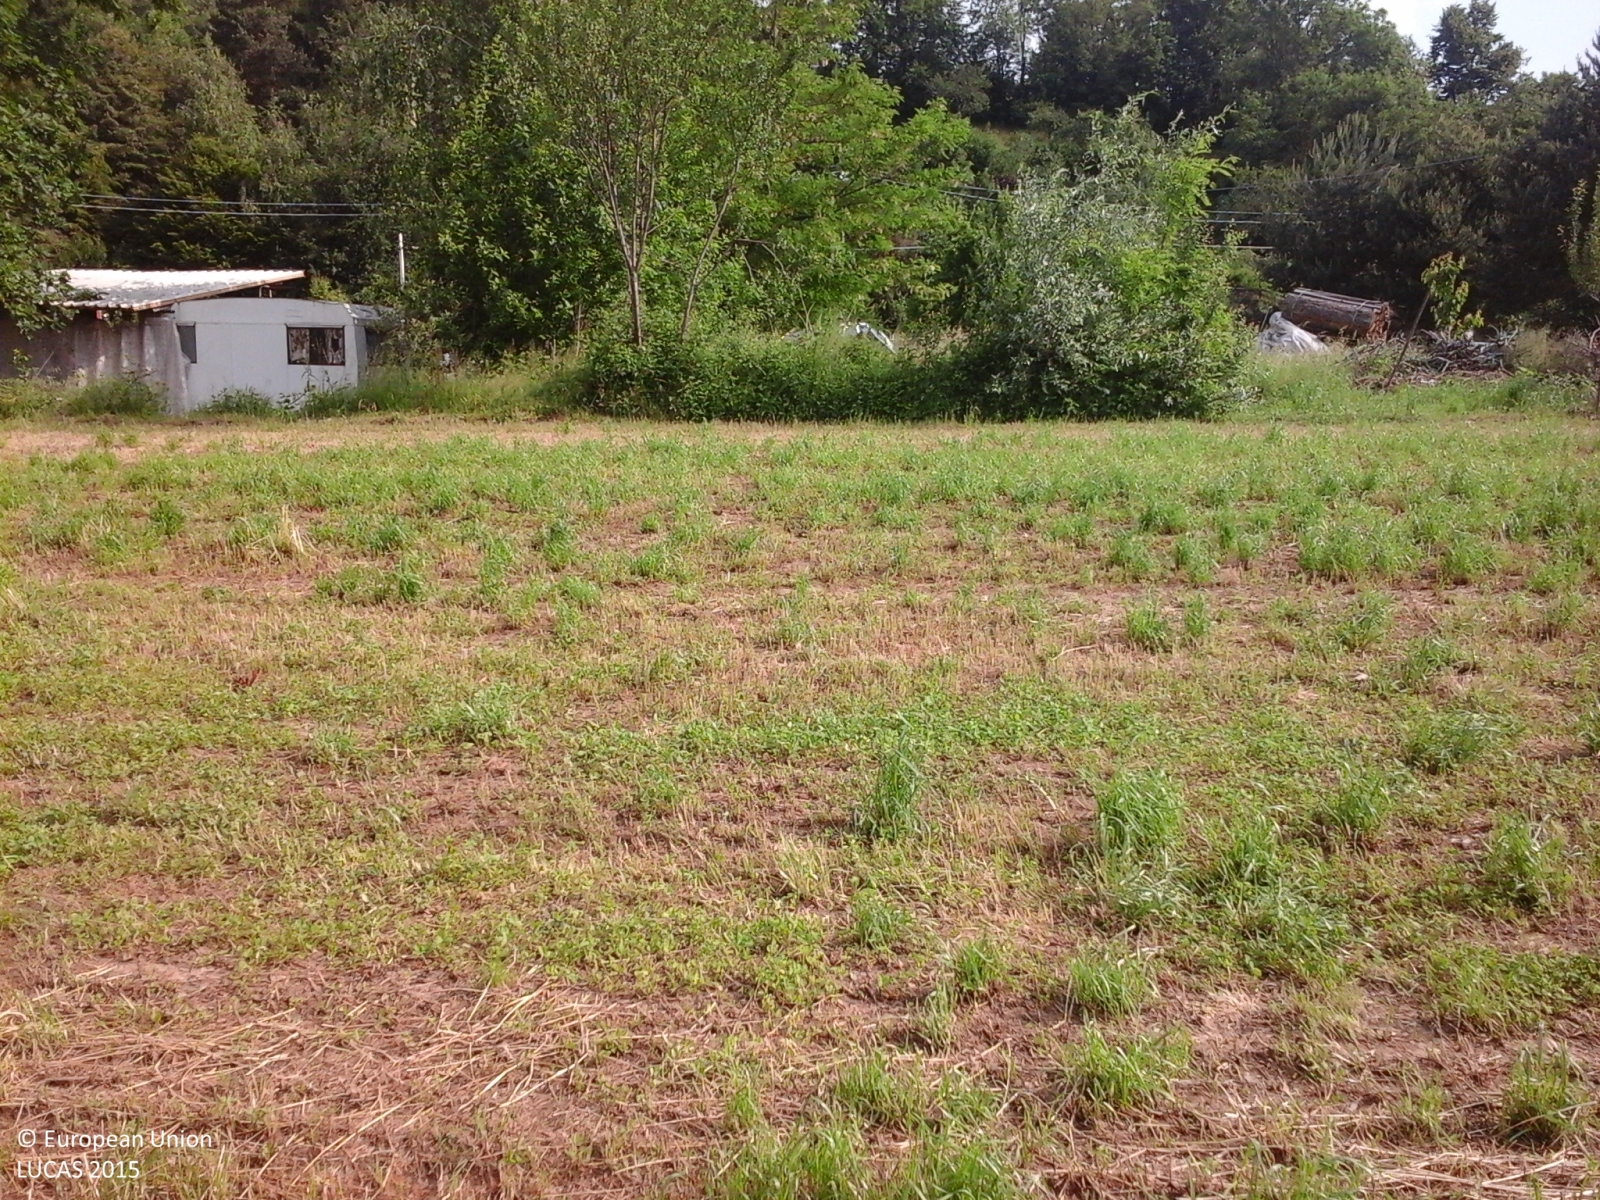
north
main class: Cropland
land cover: Temporary grasslands
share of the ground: > 75 %
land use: Agriculture (excluding fallow land and kitchen gardens)
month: May
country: IT
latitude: 44.8196
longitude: 7.2607
